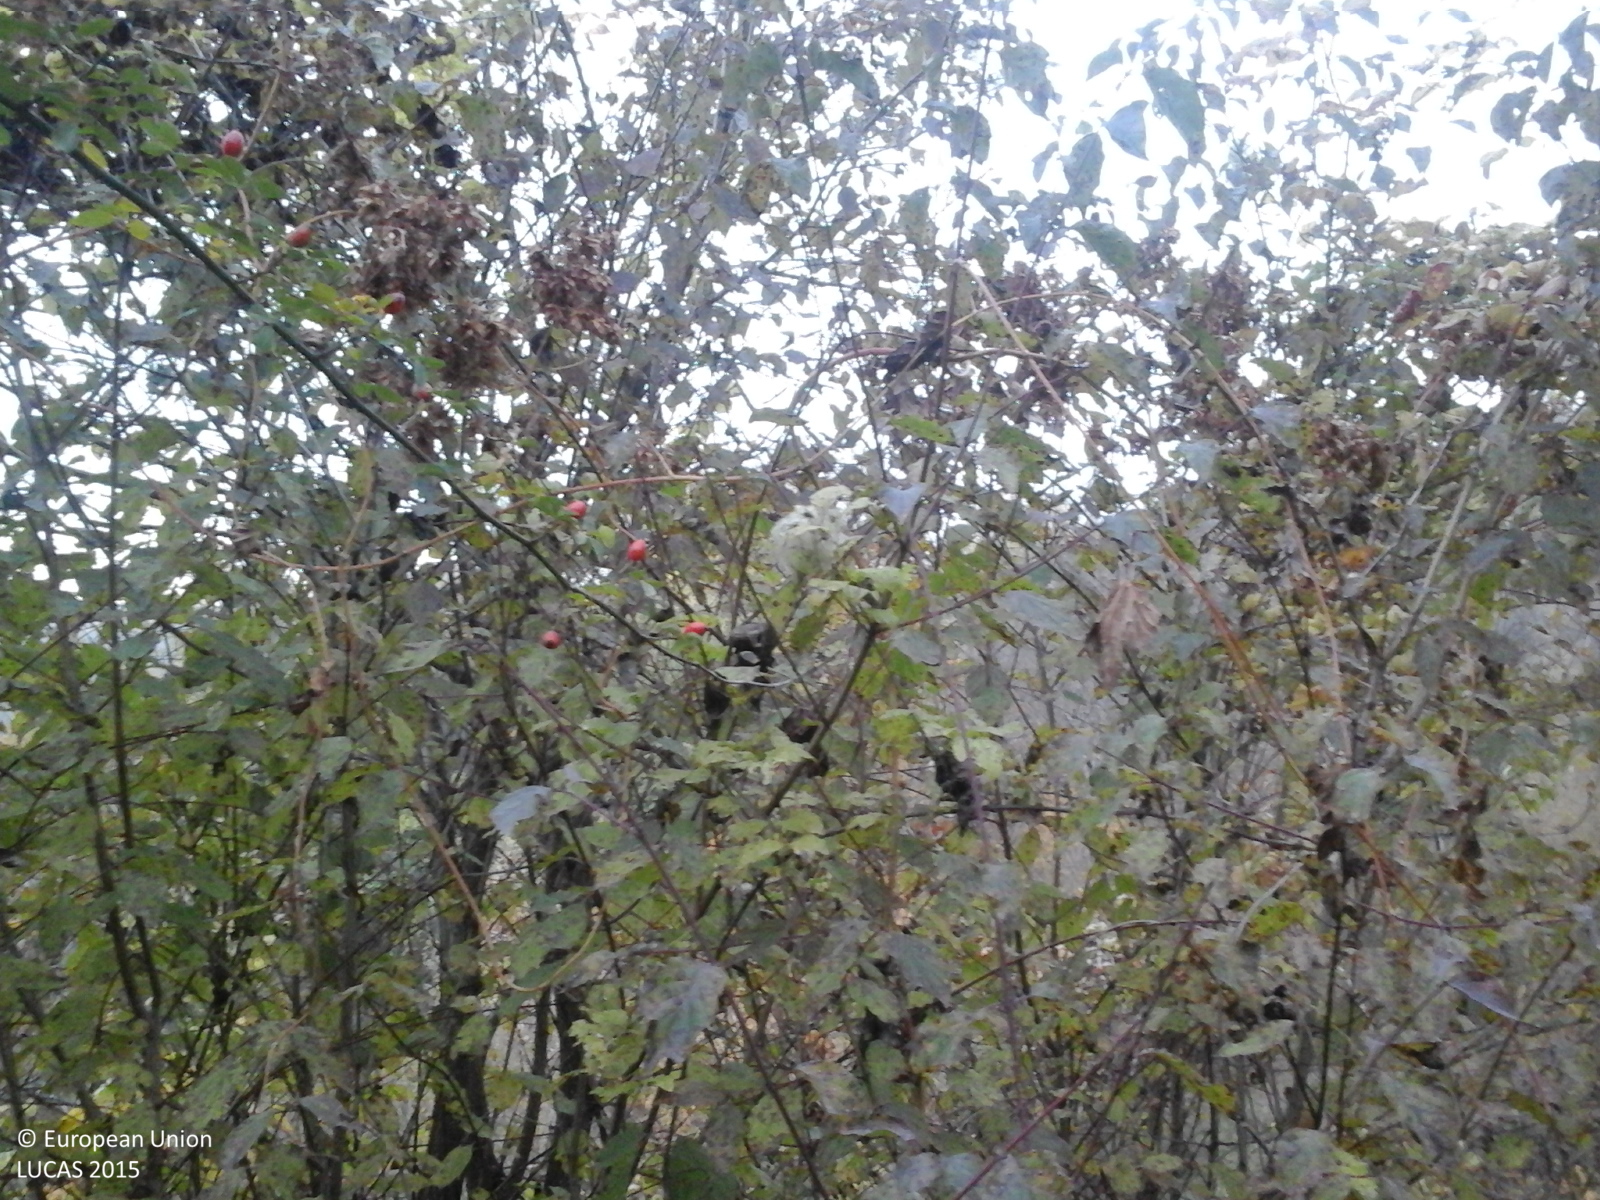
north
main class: Shrubland
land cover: Shrubland with sparse tree cover
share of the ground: > 75 %
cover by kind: shrubs 85 %, herbaceous plants 10 %, broadleaved forest trees 5 %
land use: Semi-natural and natural areas not in use
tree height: < 5 m
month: October
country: RO
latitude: 45.3562
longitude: 26.4758
